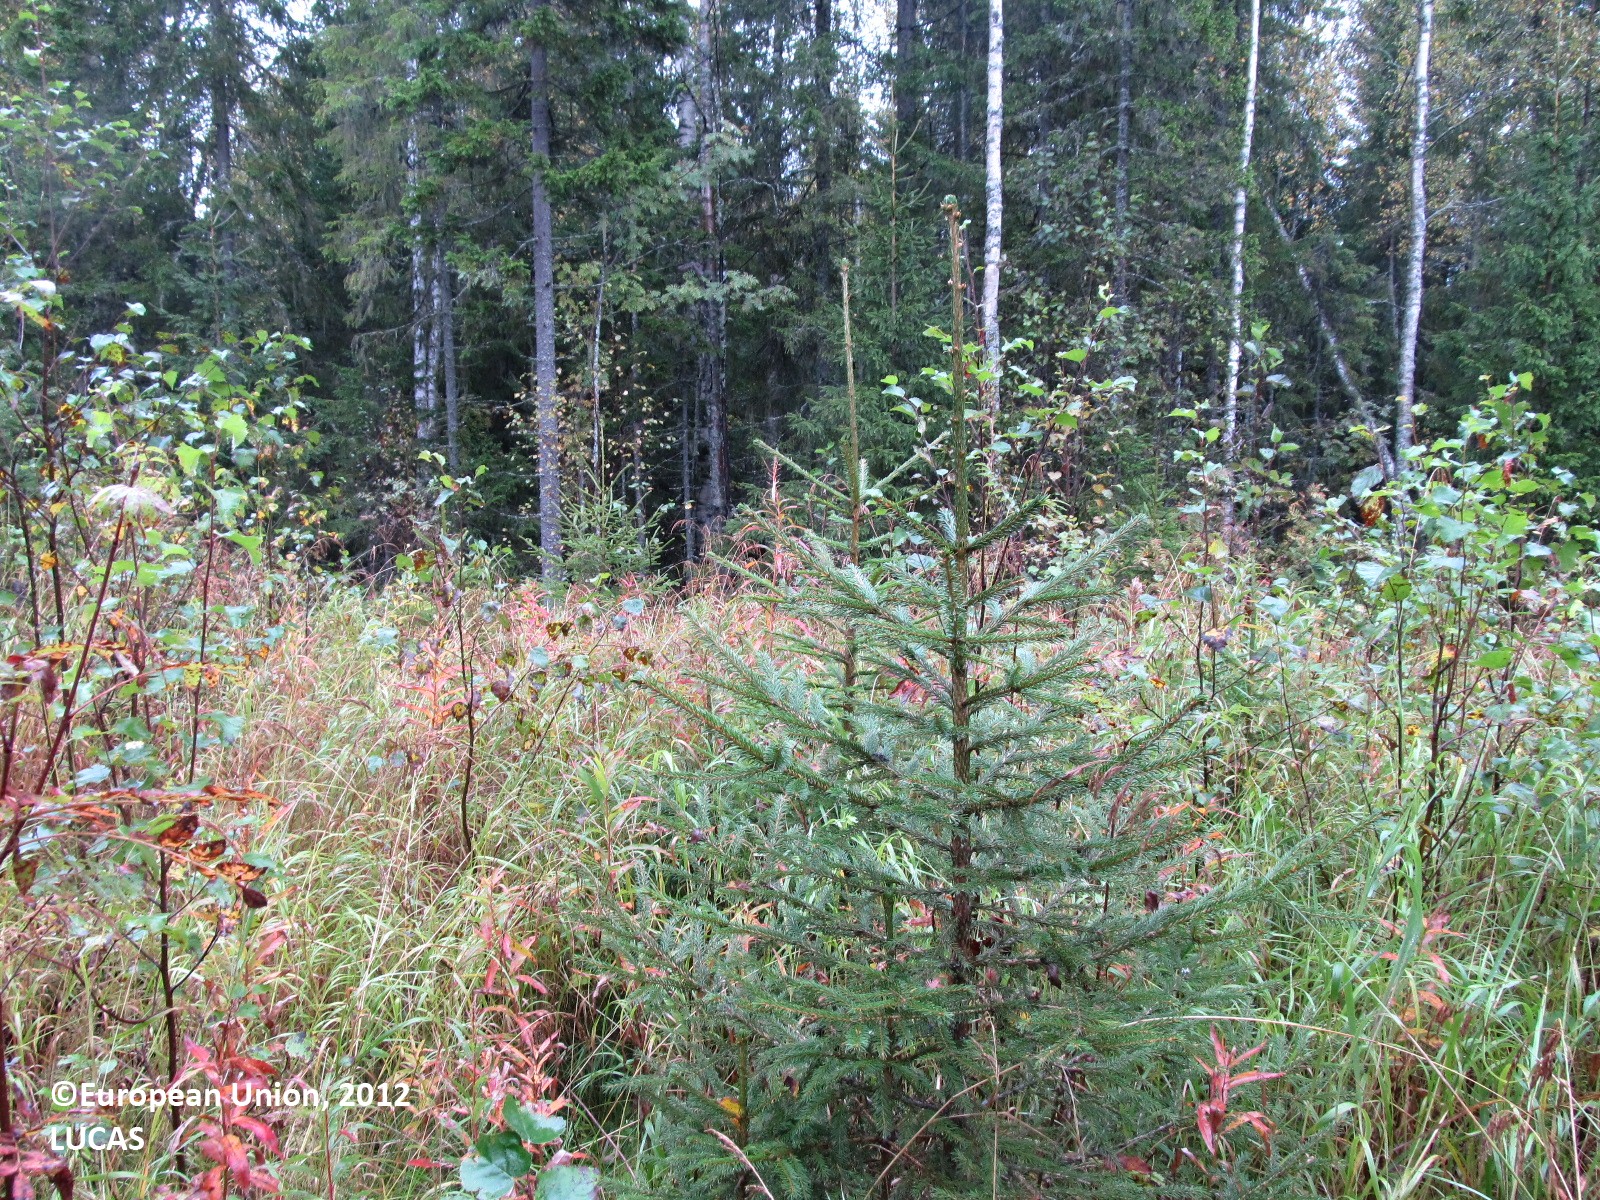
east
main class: Woodland
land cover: Spruce dominated mixed woodland
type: boreal forest
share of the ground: 25 - 50 %
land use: Forestry
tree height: < 5 m
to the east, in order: Spruce dominated mixed woodland; Ditches and canals; Spruce dominated mixed woodland; Ditches and canals; Spruce dominated mixed woodland; Ditches and canals; Broadleaved woodland; Ditches and canals; Broadleaved woodland; Ditches and canals; Broadleaved woodland; Ditches and canals; Broadleaved woodland; Ditches and canals; Broadleaved woodland; Ditches and canals; Other mixed woodland
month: September
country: FI
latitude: 63.2746
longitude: 27.8897
